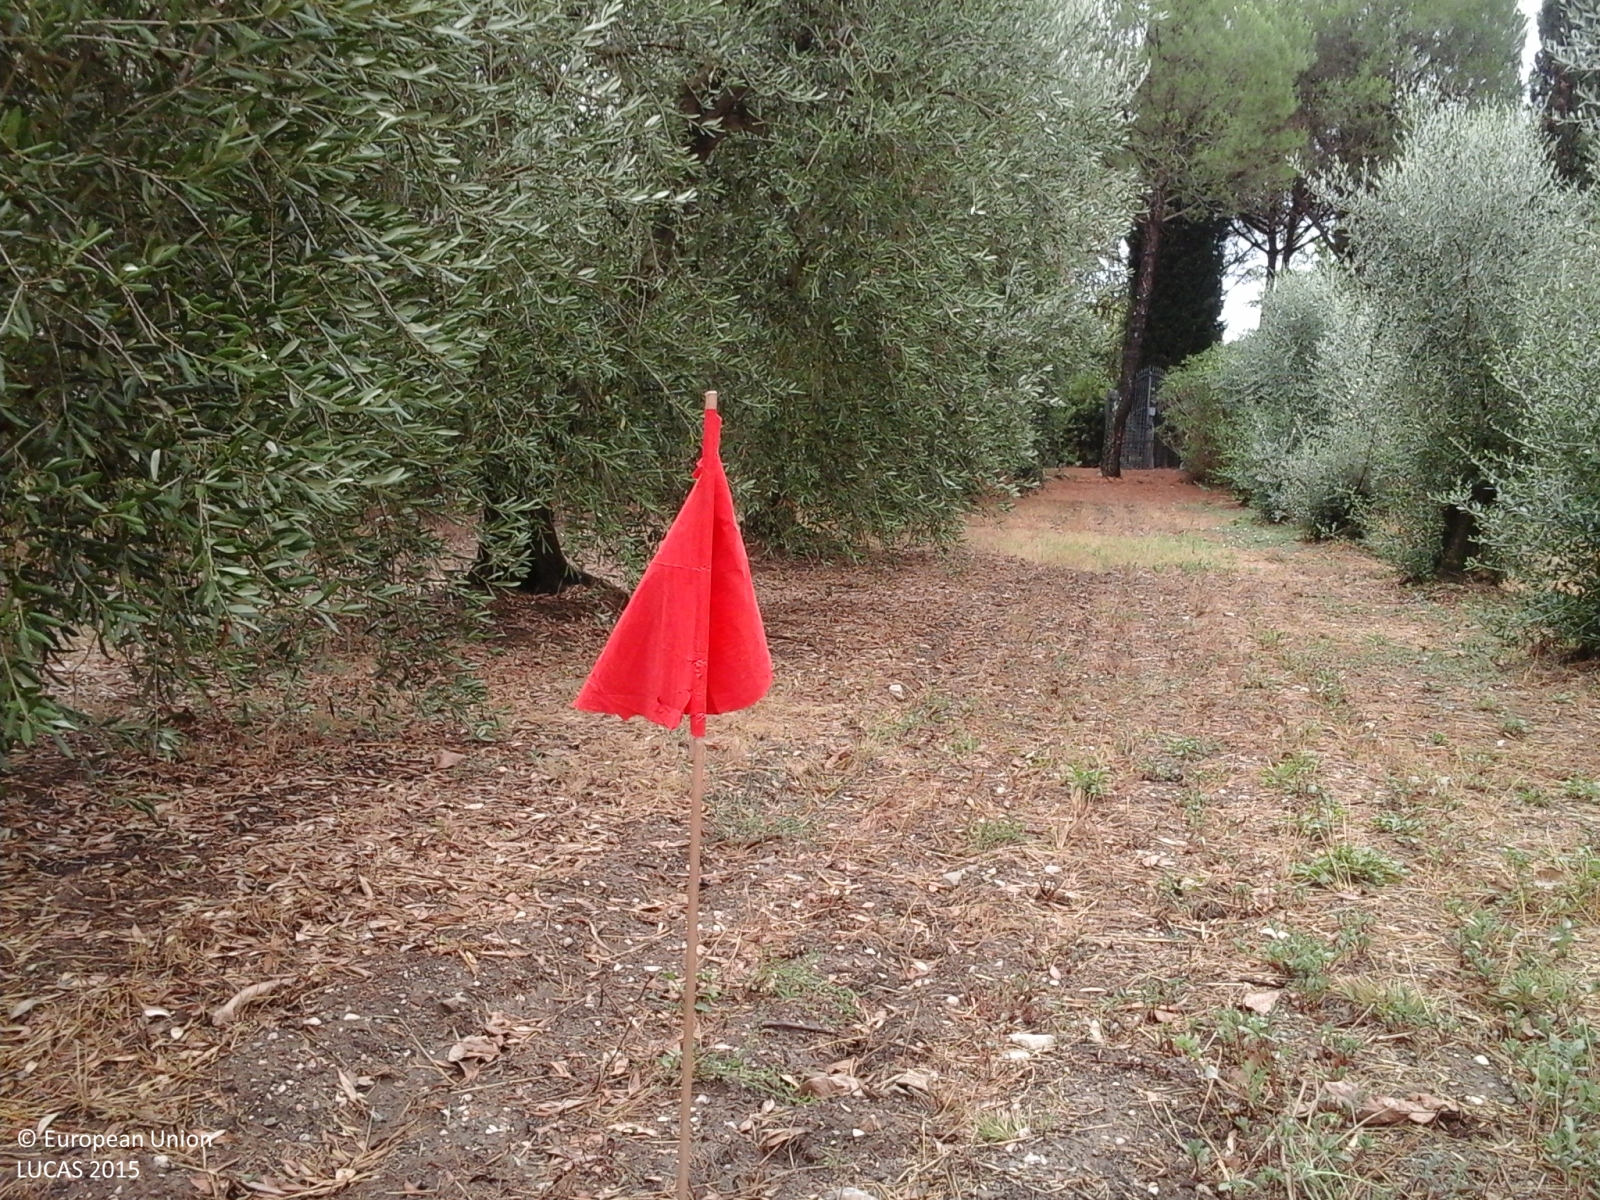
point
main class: Cropland
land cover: Olive groves
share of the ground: 50 - 75 %
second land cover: Grassland without tree/shrub cover
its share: 10 - 25 %
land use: Agriculture (excluding fallow land and kitchen gardens)
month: August
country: IT
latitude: 42.8840
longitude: 10.9886
